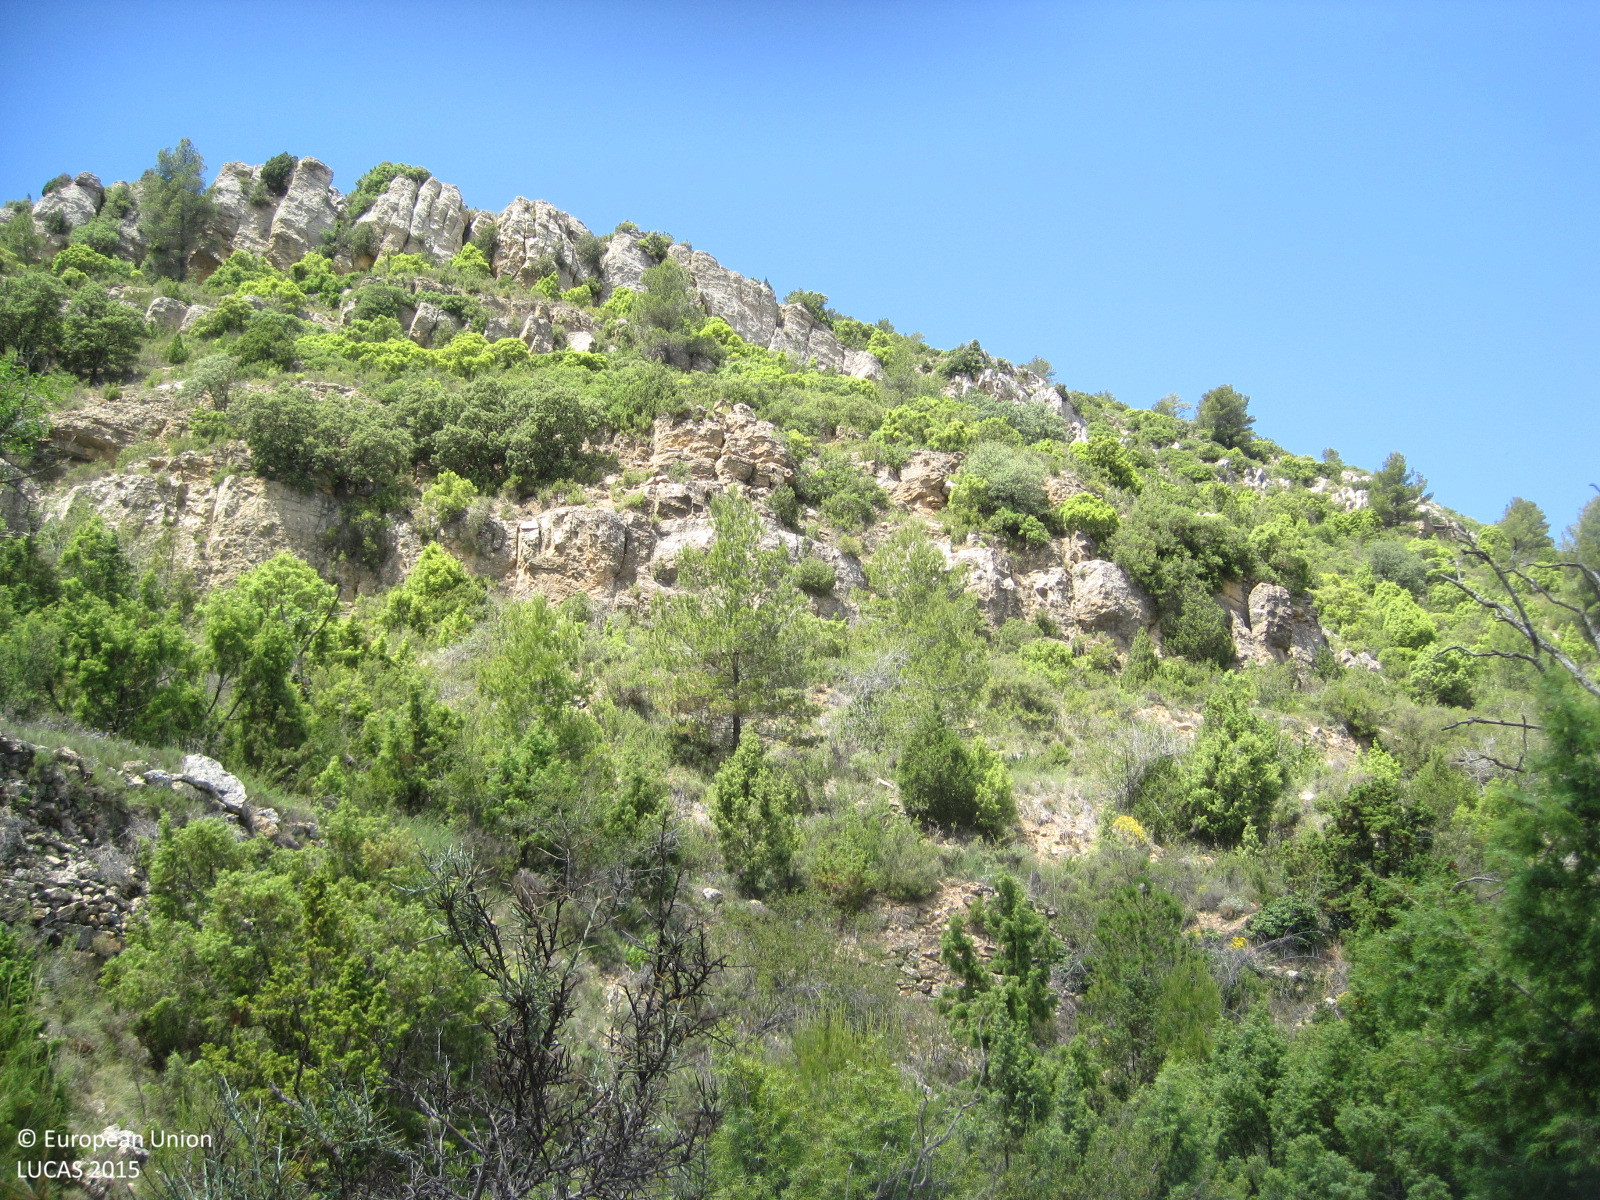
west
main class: Woodland
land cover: Broadleaved woodland
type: acidophilous oak and oak-birch forest
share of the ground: 10 - 25 %
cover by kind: broadleaved forest trees 30 %, shrubs 30 %, consolidated bare surface 25 %, herbaceous plants 10 %, coniferous forest trees 5 %
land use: Forestry
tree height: < 5 m
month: June
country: ES
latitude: 39.8678
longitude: -0.9824
